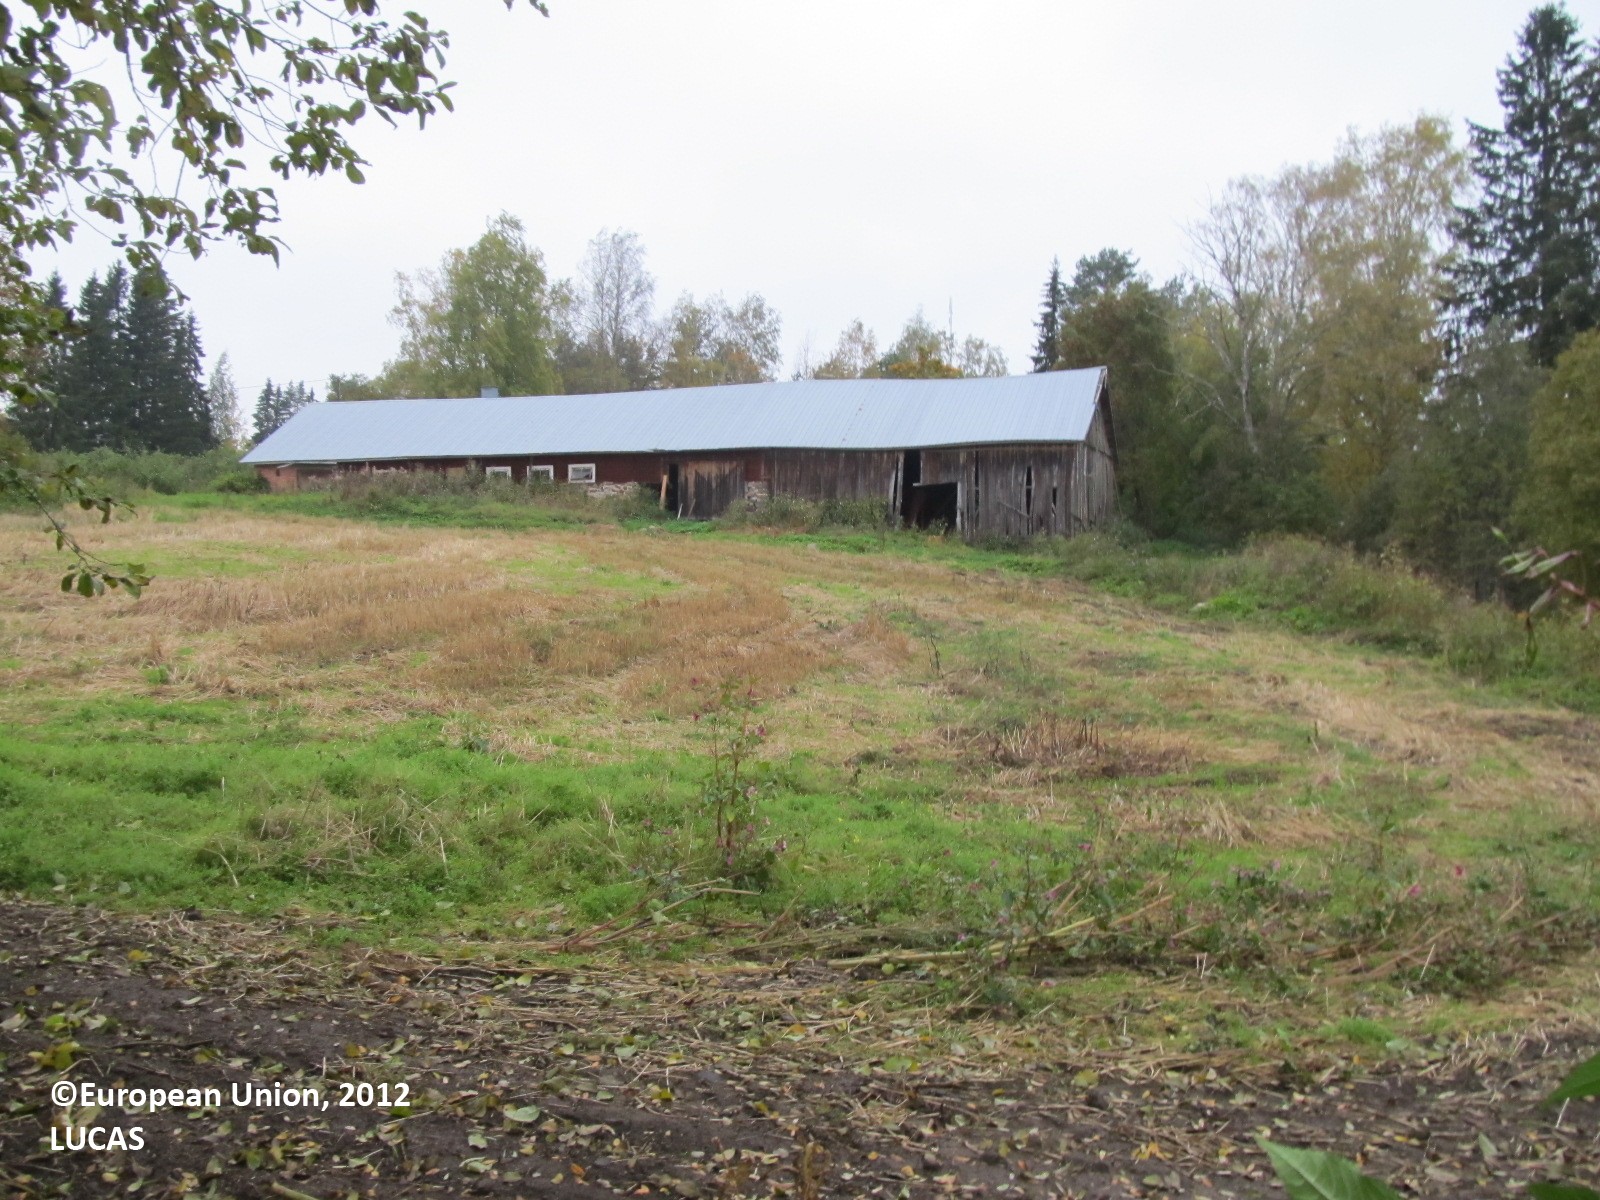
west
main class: Shrubland
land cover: Shrubland with sparse tree cover
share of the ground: > 75 %
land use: Semi-natural and natural areas not in use
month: September
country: FI
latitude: 62.2600
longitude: 28.1197
